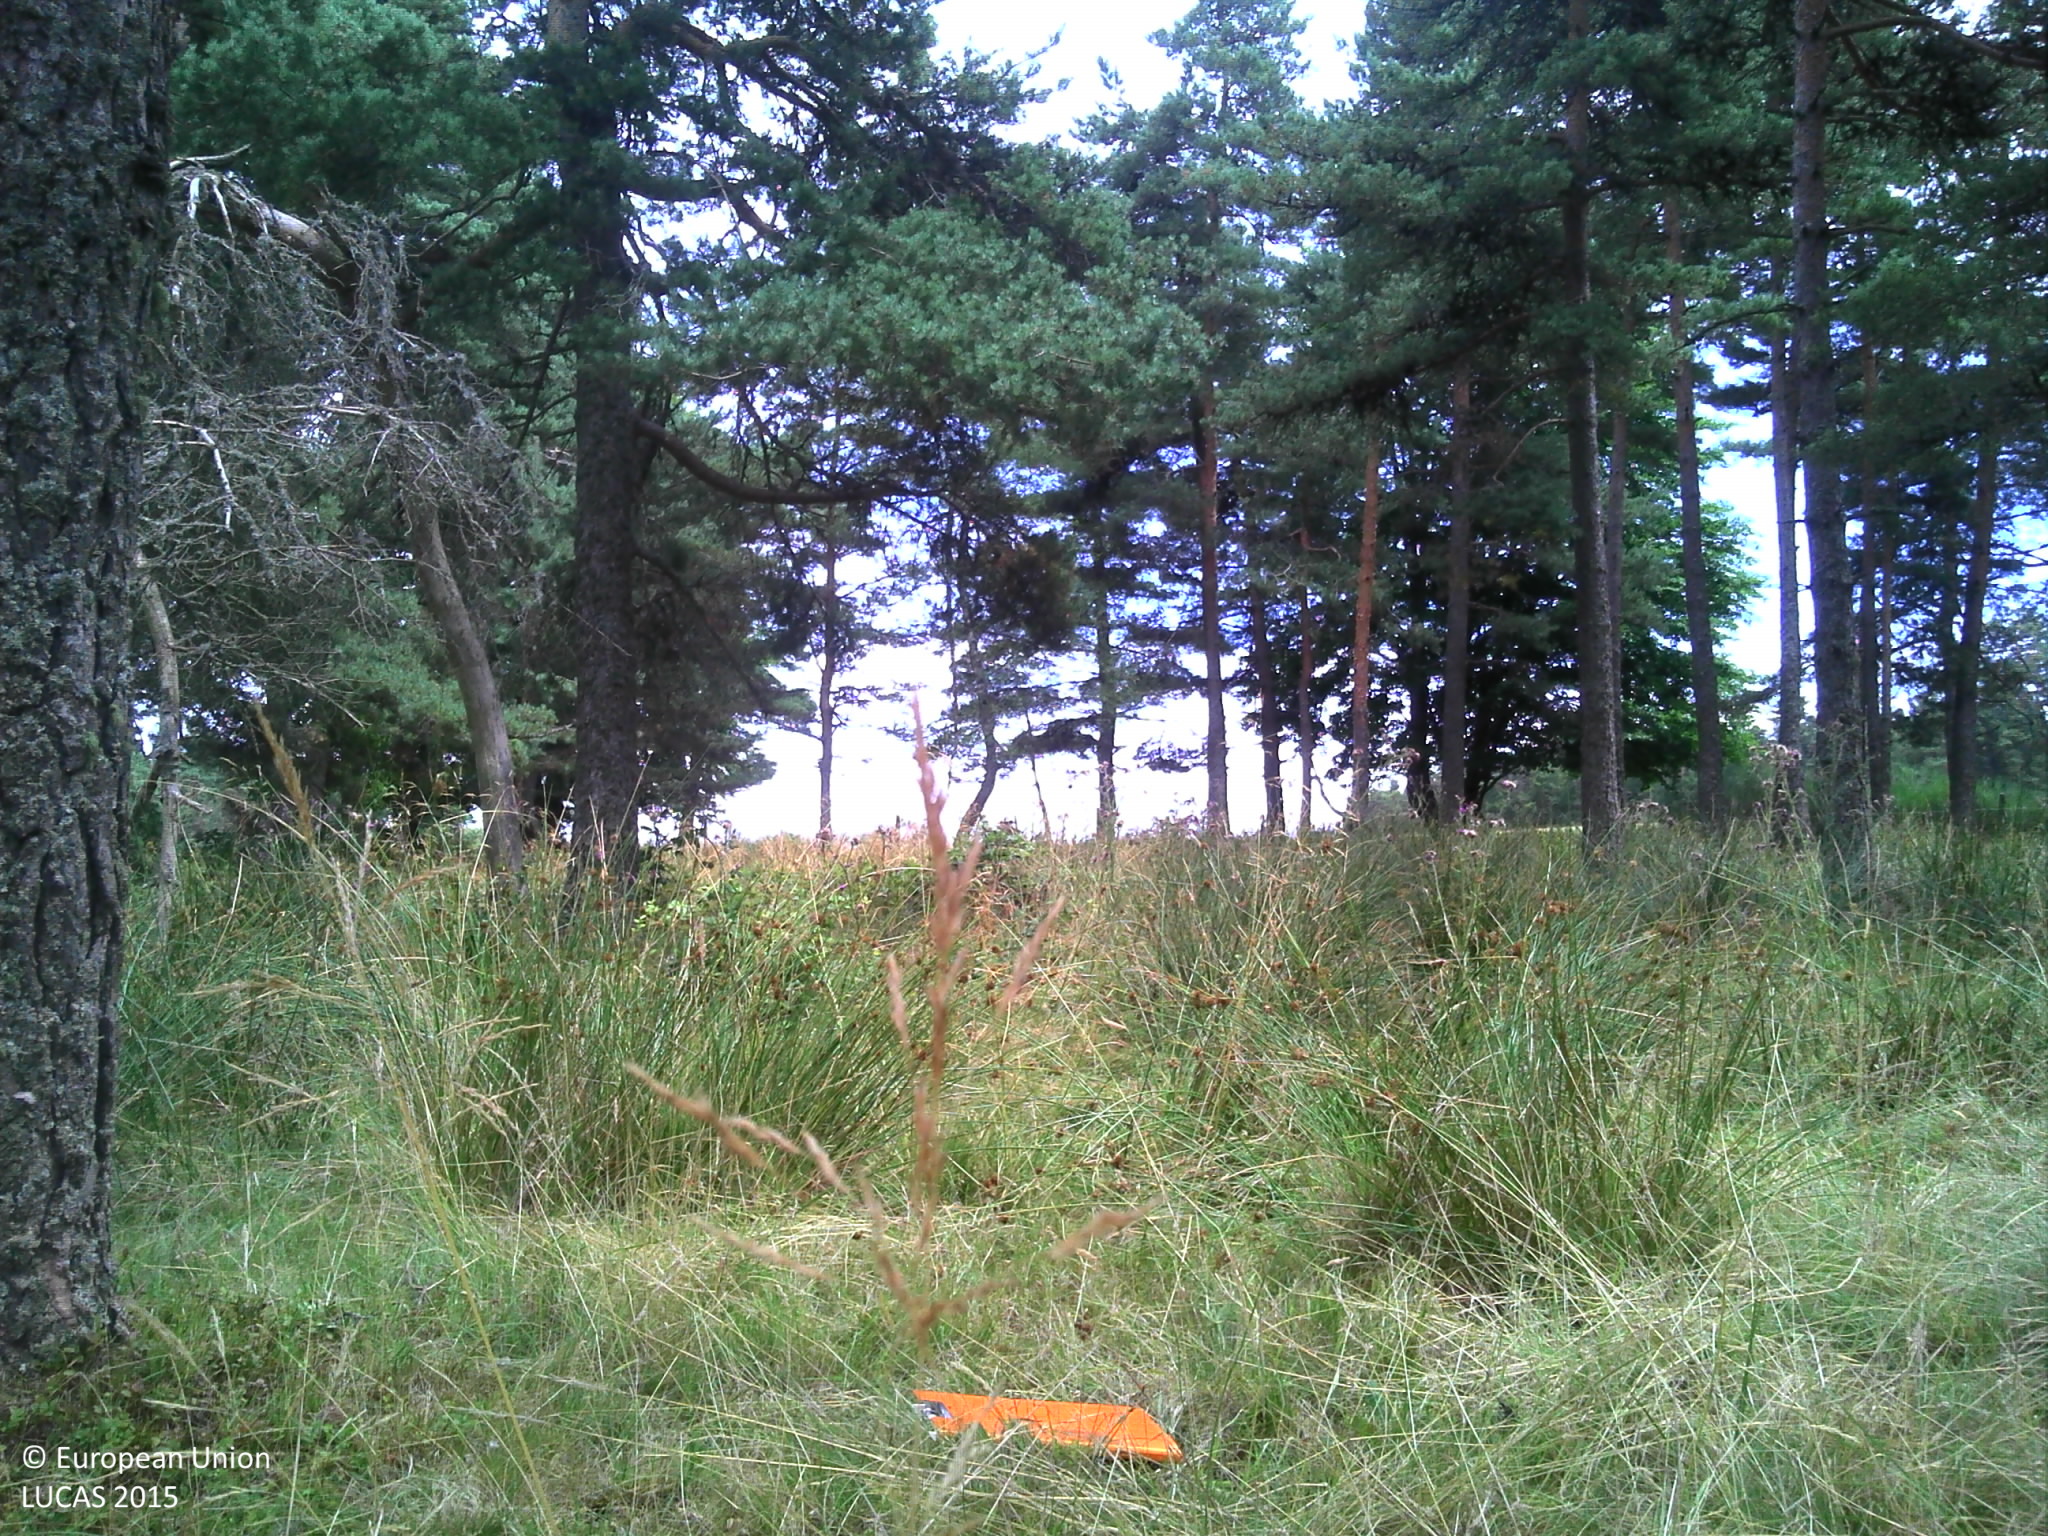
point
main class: Woodland
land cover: Pine dominated coniferous woodland
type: alpine coniferous forest
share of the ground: > 75 %
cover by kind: coniferous forest trees 75 %, broadleaved forest trees 25 %
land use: Forestry
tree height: > 5 m
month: July
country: FR
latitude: 44.8516
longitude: 3.2085
